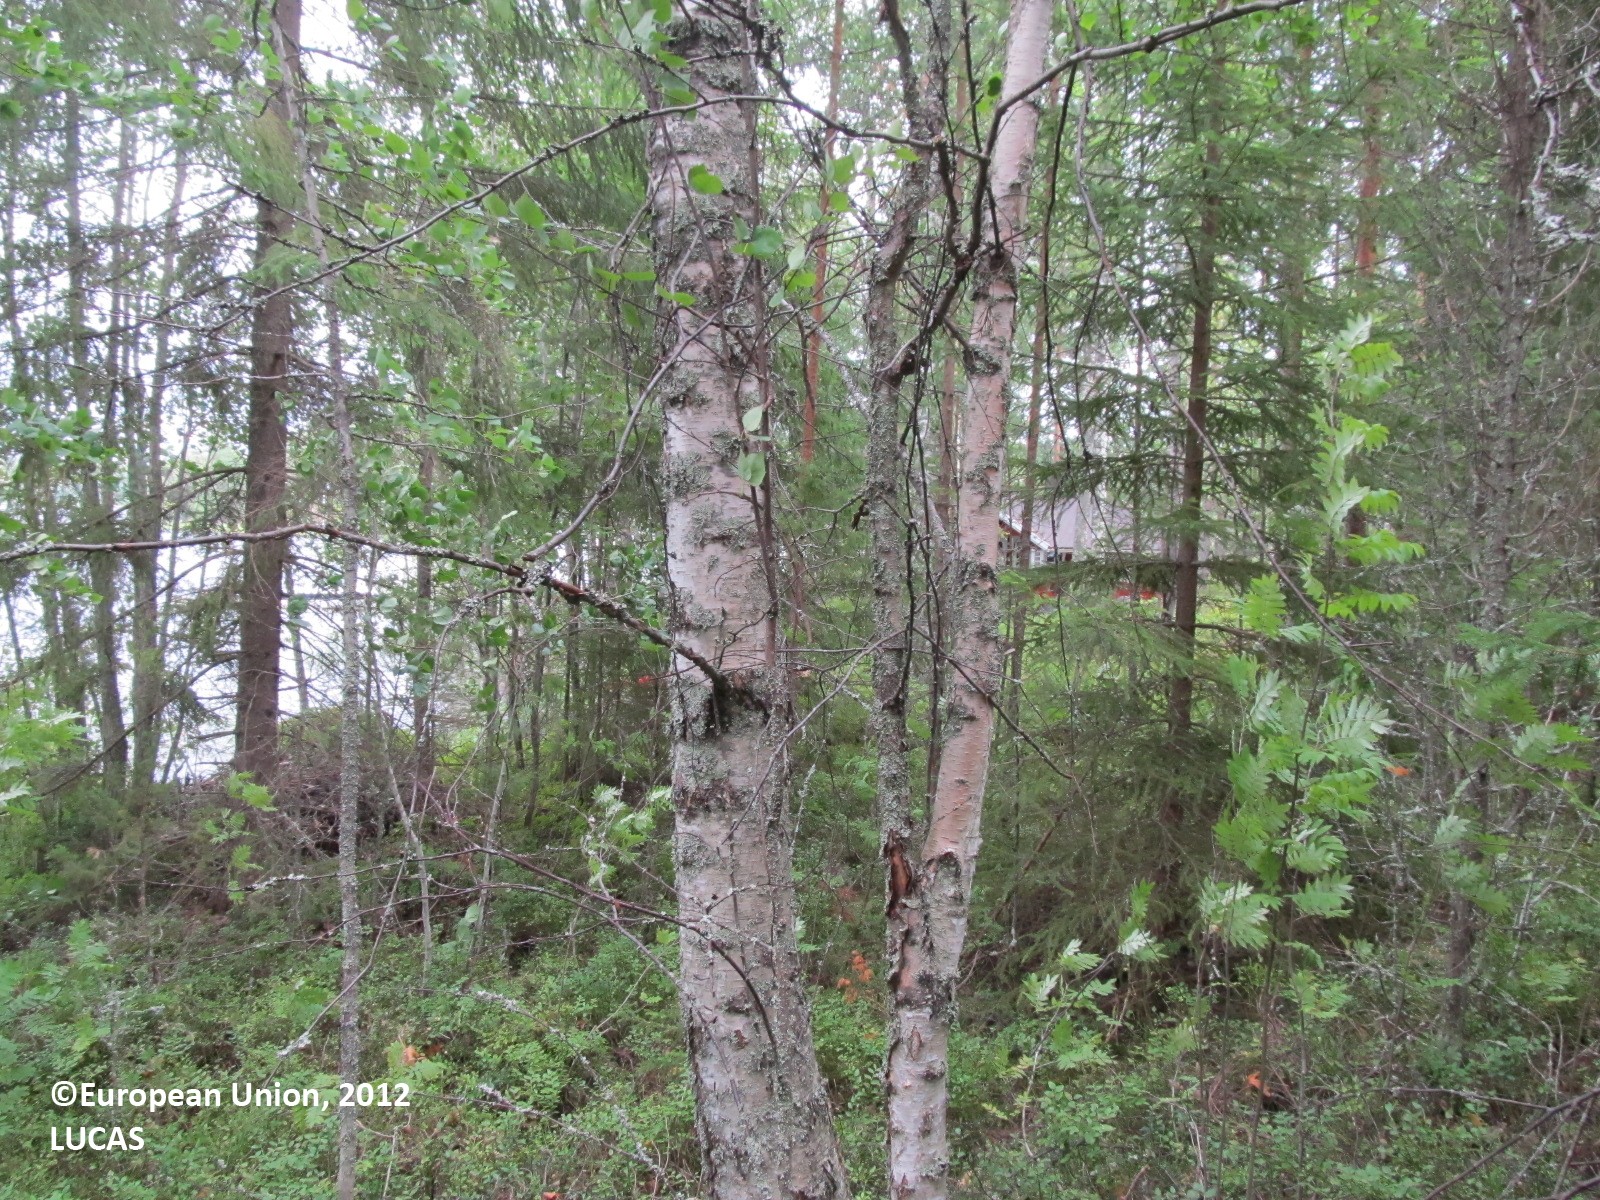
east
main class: Woodland
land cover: Spruce dominated mixed woodland
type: boreal forest
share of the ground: 25 - 50 %
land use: Forestry
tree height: > 5 m
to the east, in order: Spruce dominated mixed woodland; Artificial constructions in urban areas; Pine dominated mixed woodland; Inland water bodies
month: August
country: FI
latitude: 62.1780
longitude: 28.0306
